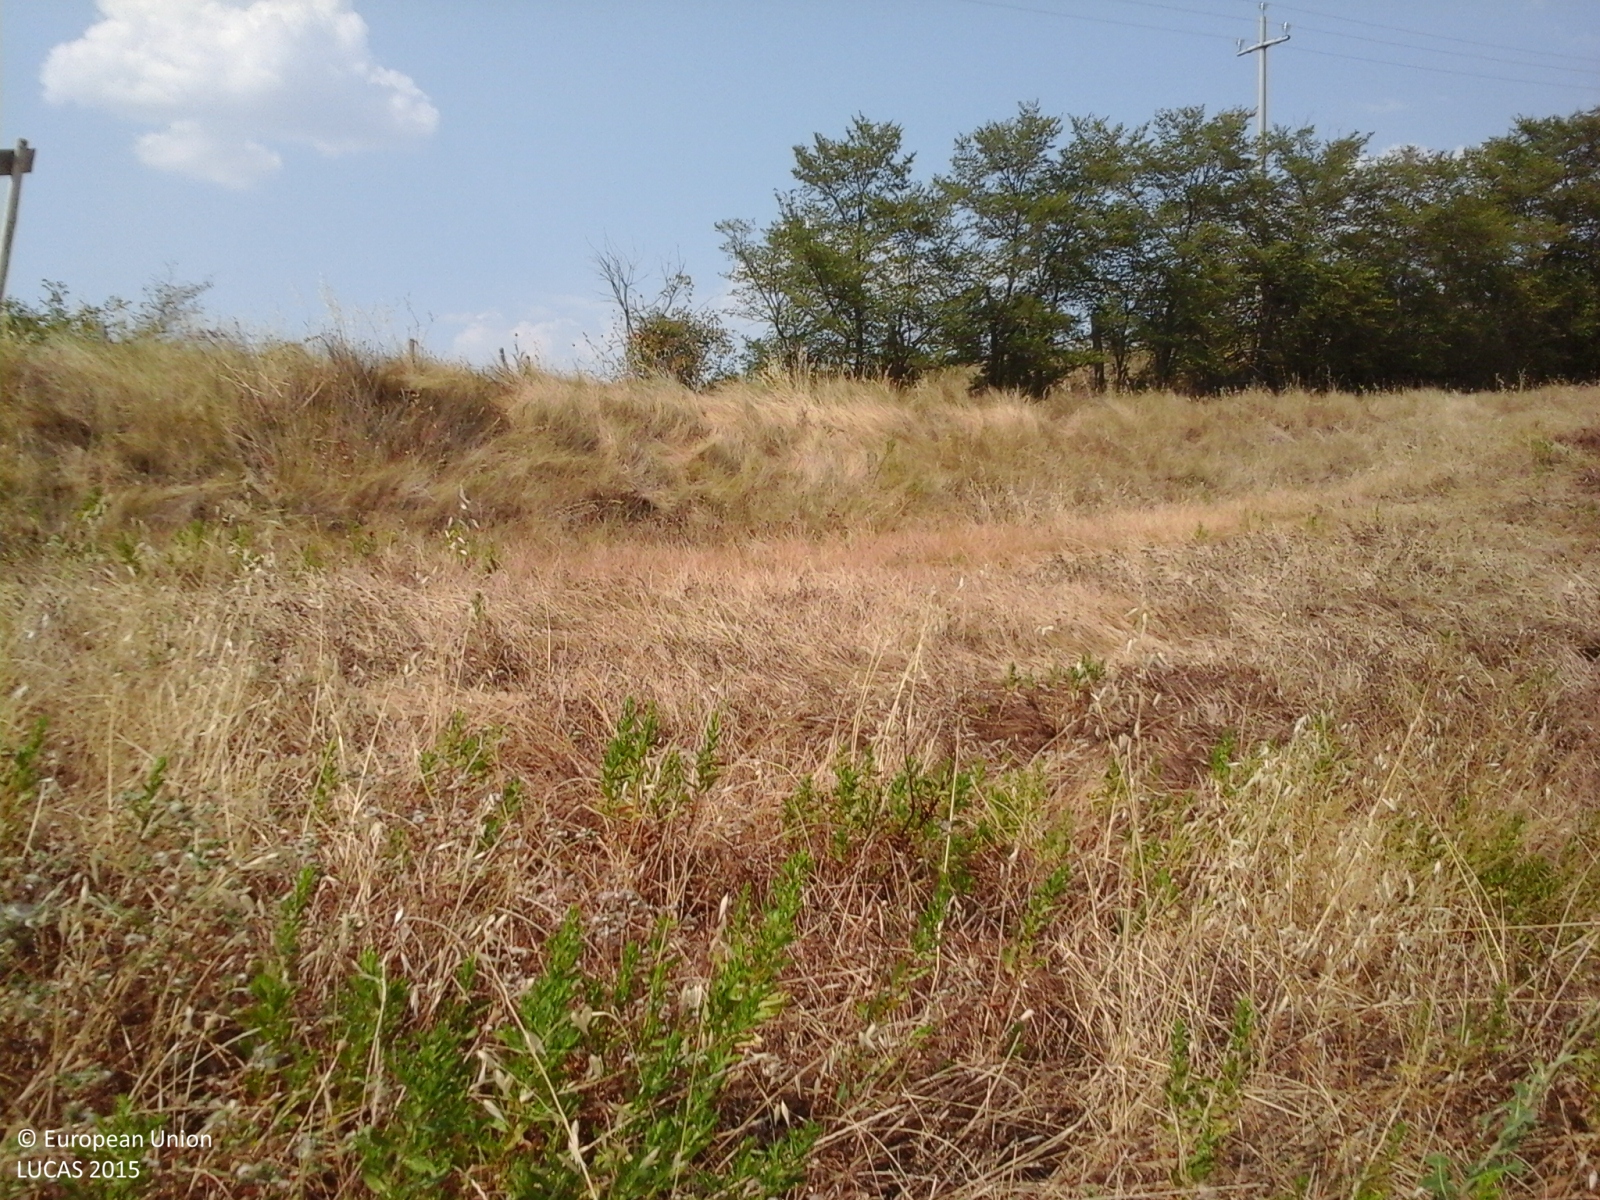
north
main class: Cropland
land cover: Temporary grasslands
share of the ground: > 75 %
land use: Agriculture (excluding fallow land and kitchen gardens)
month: July
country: IT
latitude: 43.1481
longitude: 11.5325
